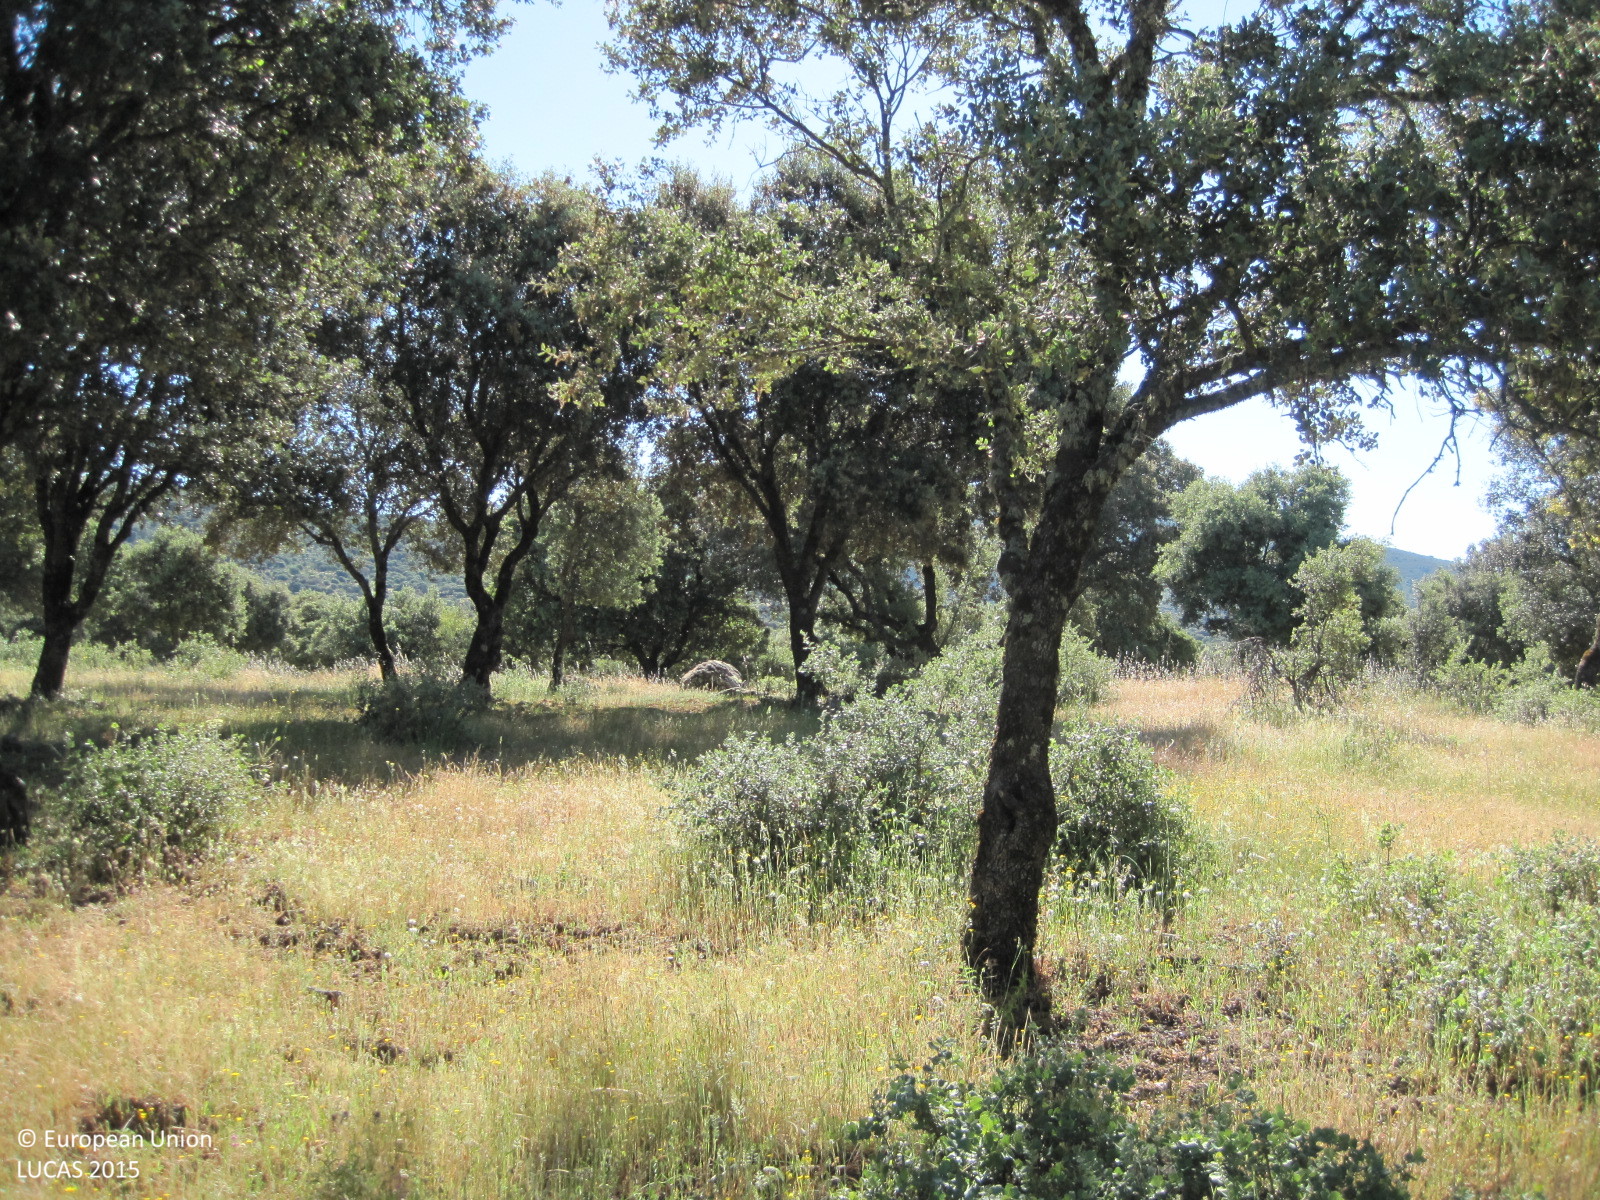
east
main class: Woodland
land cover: Broadleaved woodland
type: broadleaved evergreen forest
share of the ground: > 75 %
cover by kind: shrubs 85 %, broadleaved forest trees 15 %
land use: Semi-natural and natural areas not in use
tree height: > 5 m
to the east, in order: Broadleaved woodland; Tracks; Broadleaved woodland
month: May
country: ES
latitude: 40.1609
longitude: -4.8325
